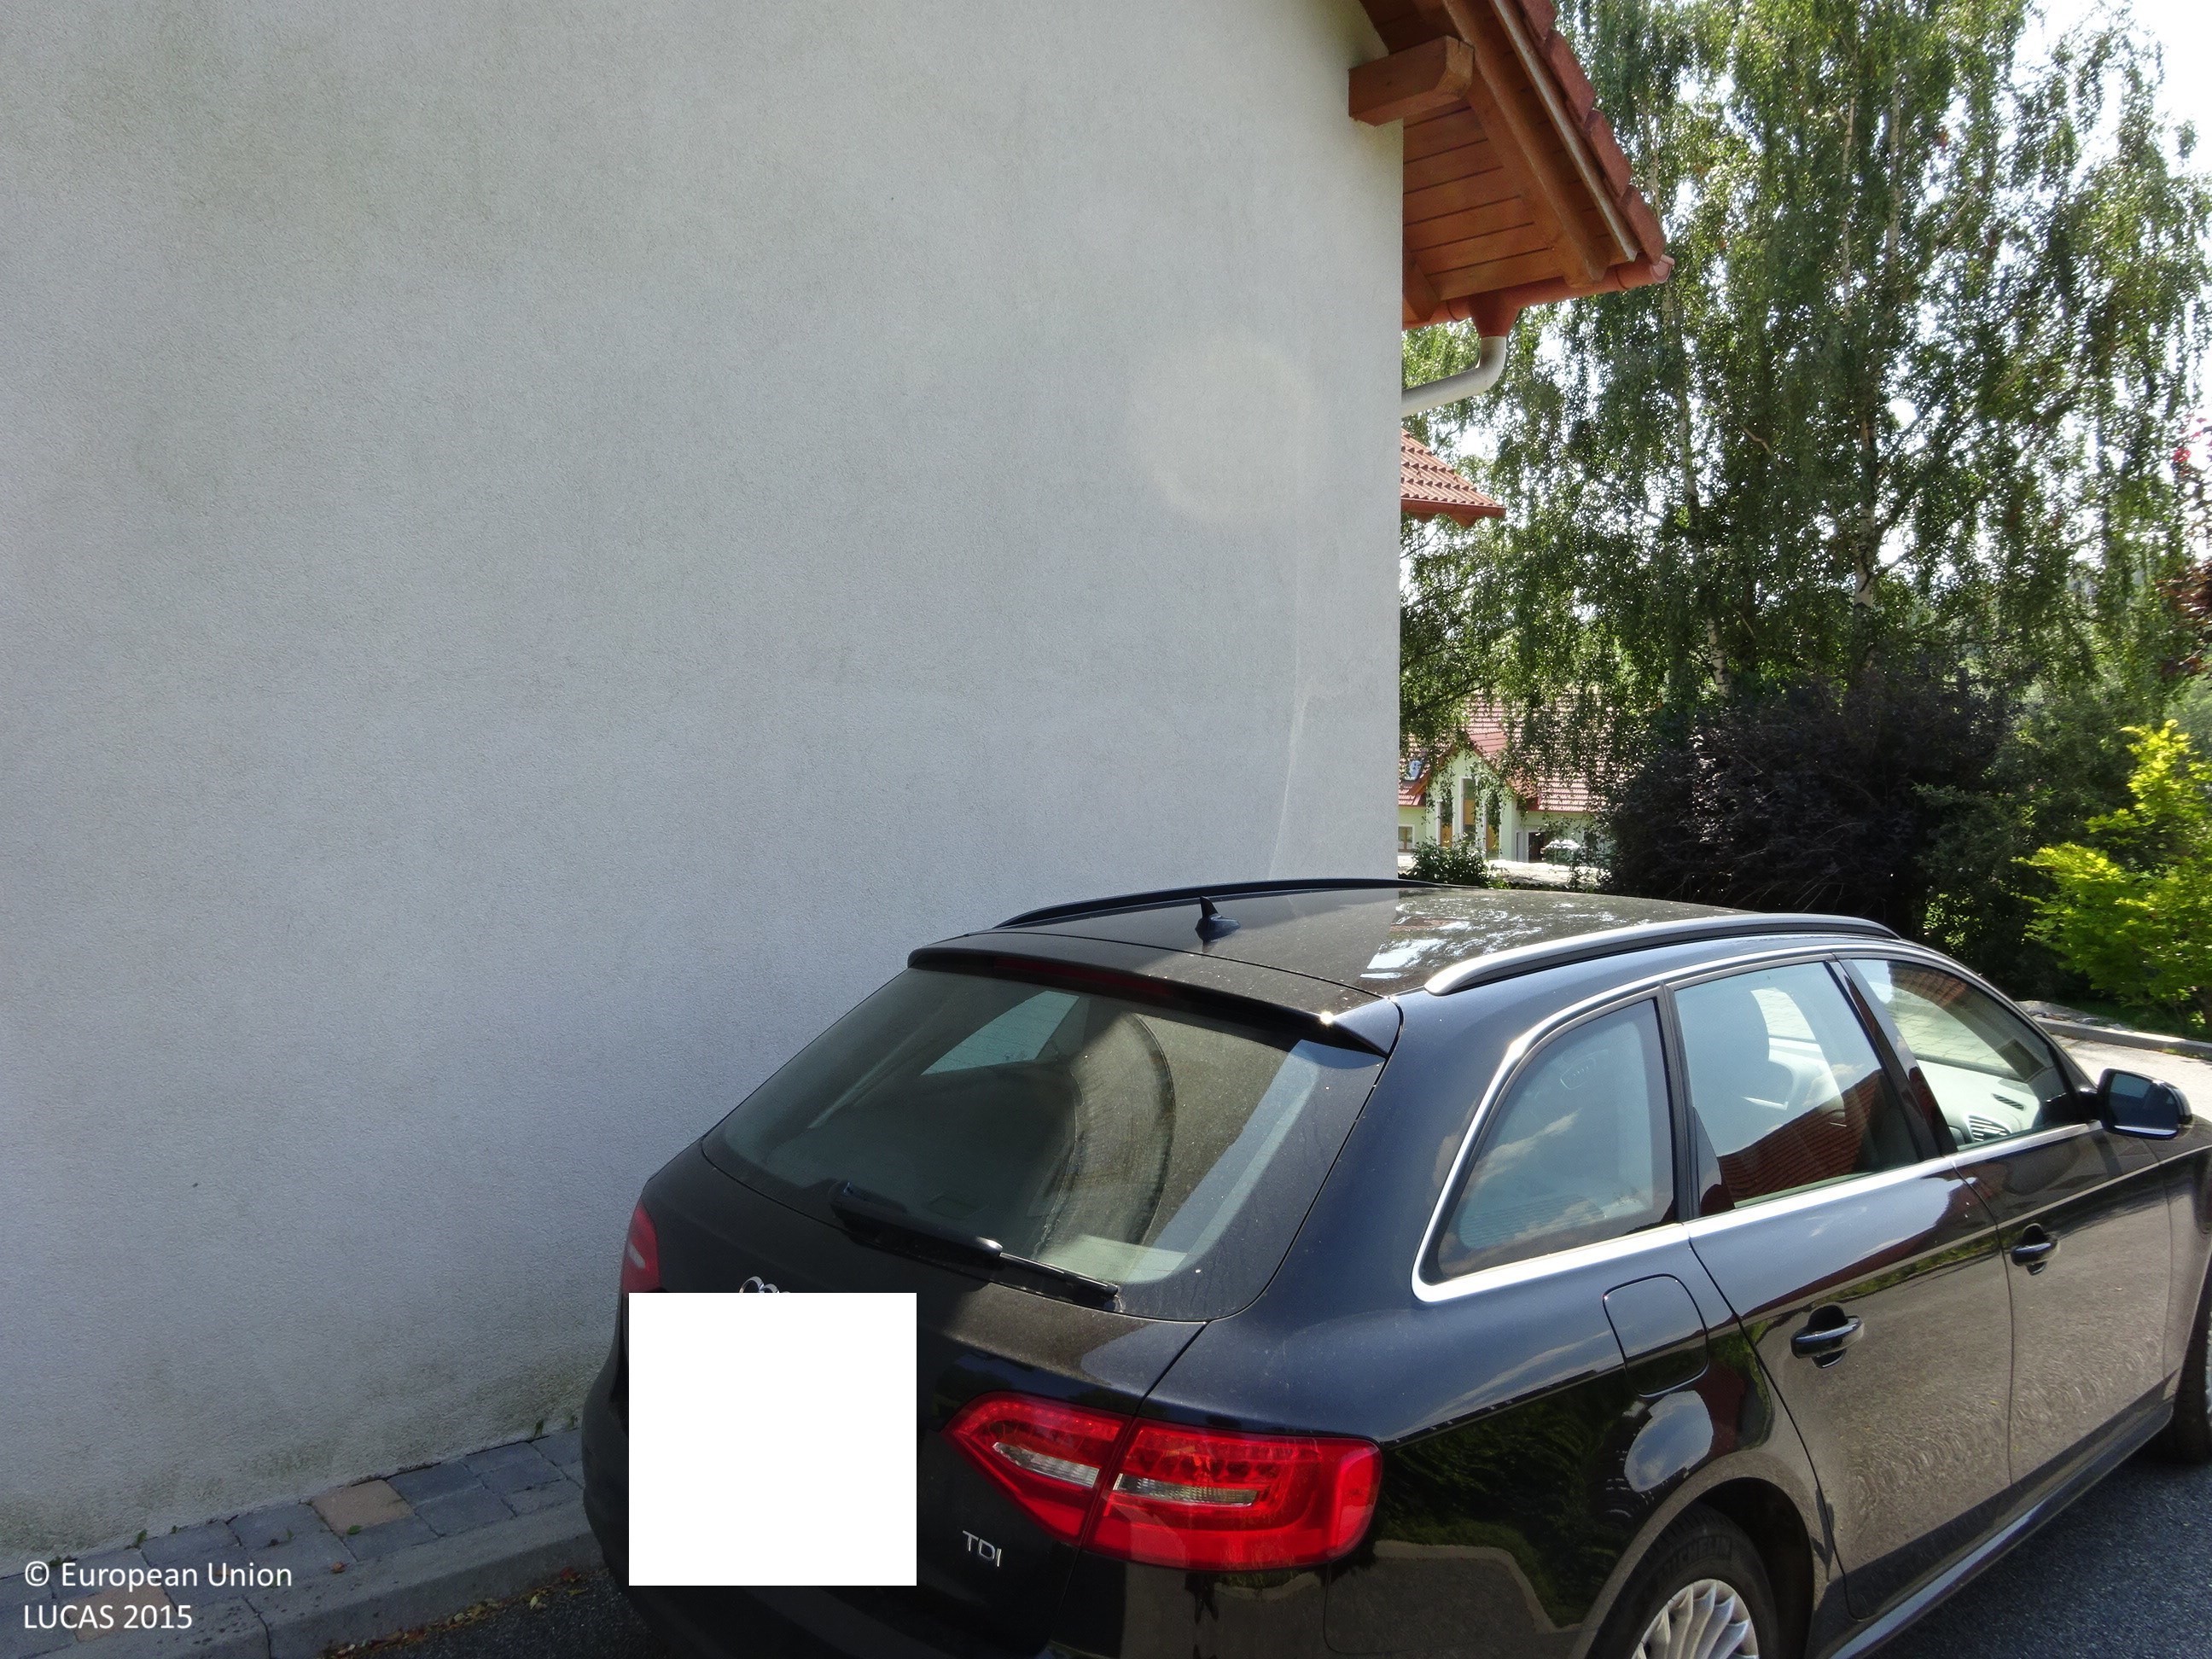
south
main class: Grassland
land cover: Grassland with sparse tree/shrub cover
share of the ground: 25 - 50 %
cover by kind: herbaceous plants 55 %, consolidated bare surface 40 %, broadleaved forest trees 5 %
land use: Residential
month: August
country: AT
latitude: 47.4266
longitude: 16.0340
